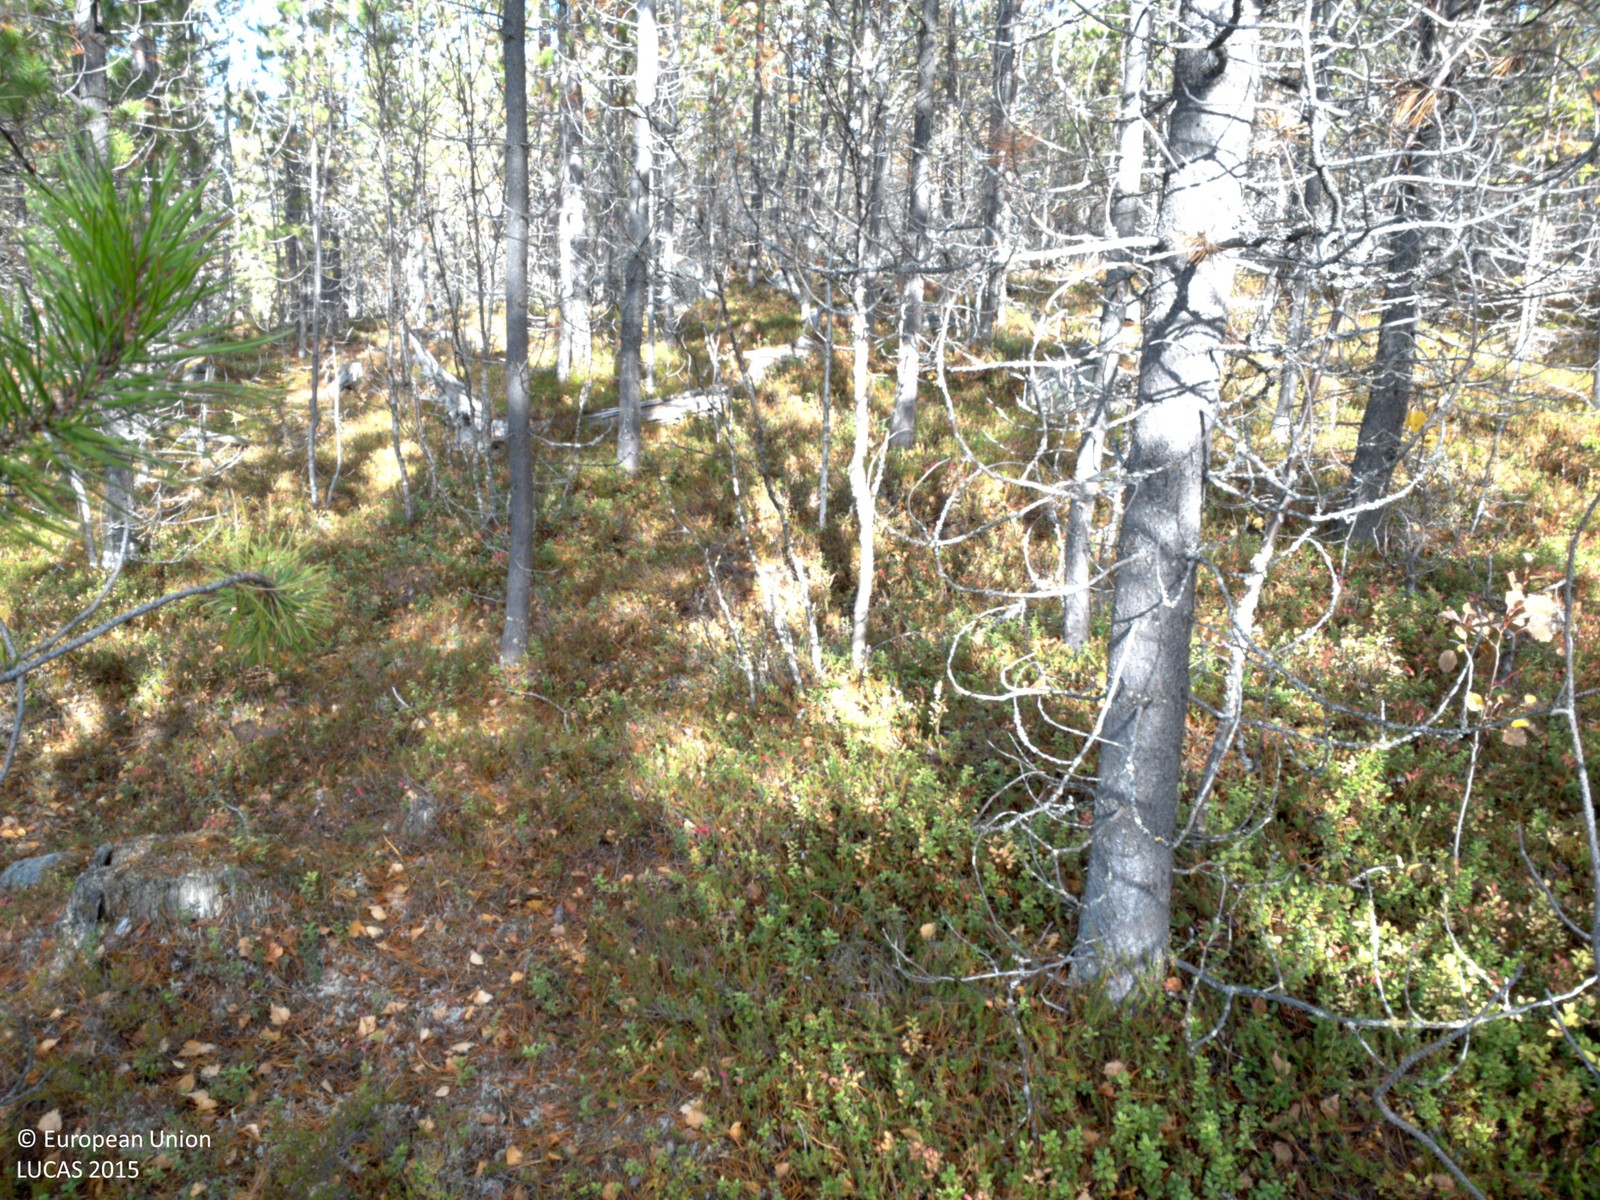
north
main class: Woodland
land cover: Pine dominated coniferous woodland
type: exotic forest
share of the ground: > 75 %
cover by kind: coniferous forest trees 75 %, shrubs 15 %, lichens and mosses 10 %
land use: Forestry
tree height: > 5 m
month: October
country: SE
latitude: 64.8067
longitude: 17.7763
